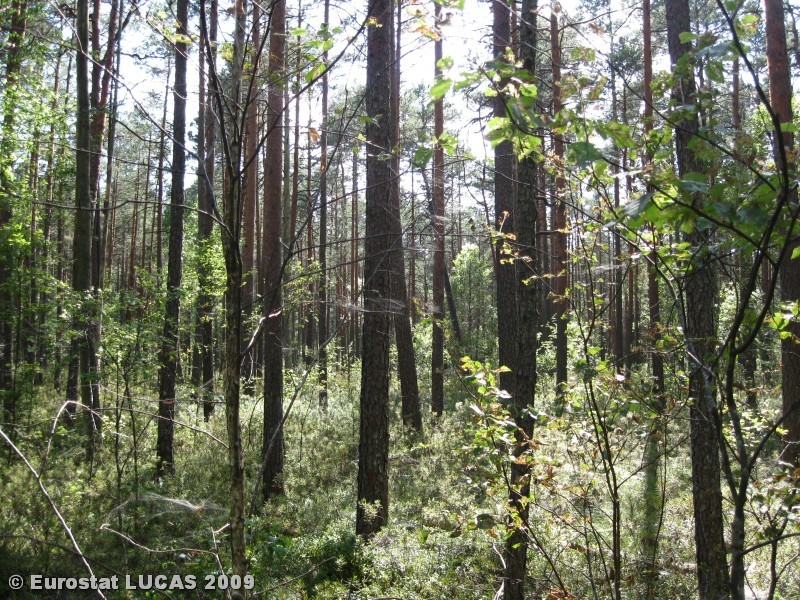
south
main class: Woodland
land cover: Mixed woodland
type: hemiboreal forest and nemoral coniferous forest and mixed broadleaved-coniferous forest
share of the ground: > 75 %
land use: Forestry
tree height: > 5 m
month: August
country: LT
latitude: 54.8050
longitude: 23.5709
